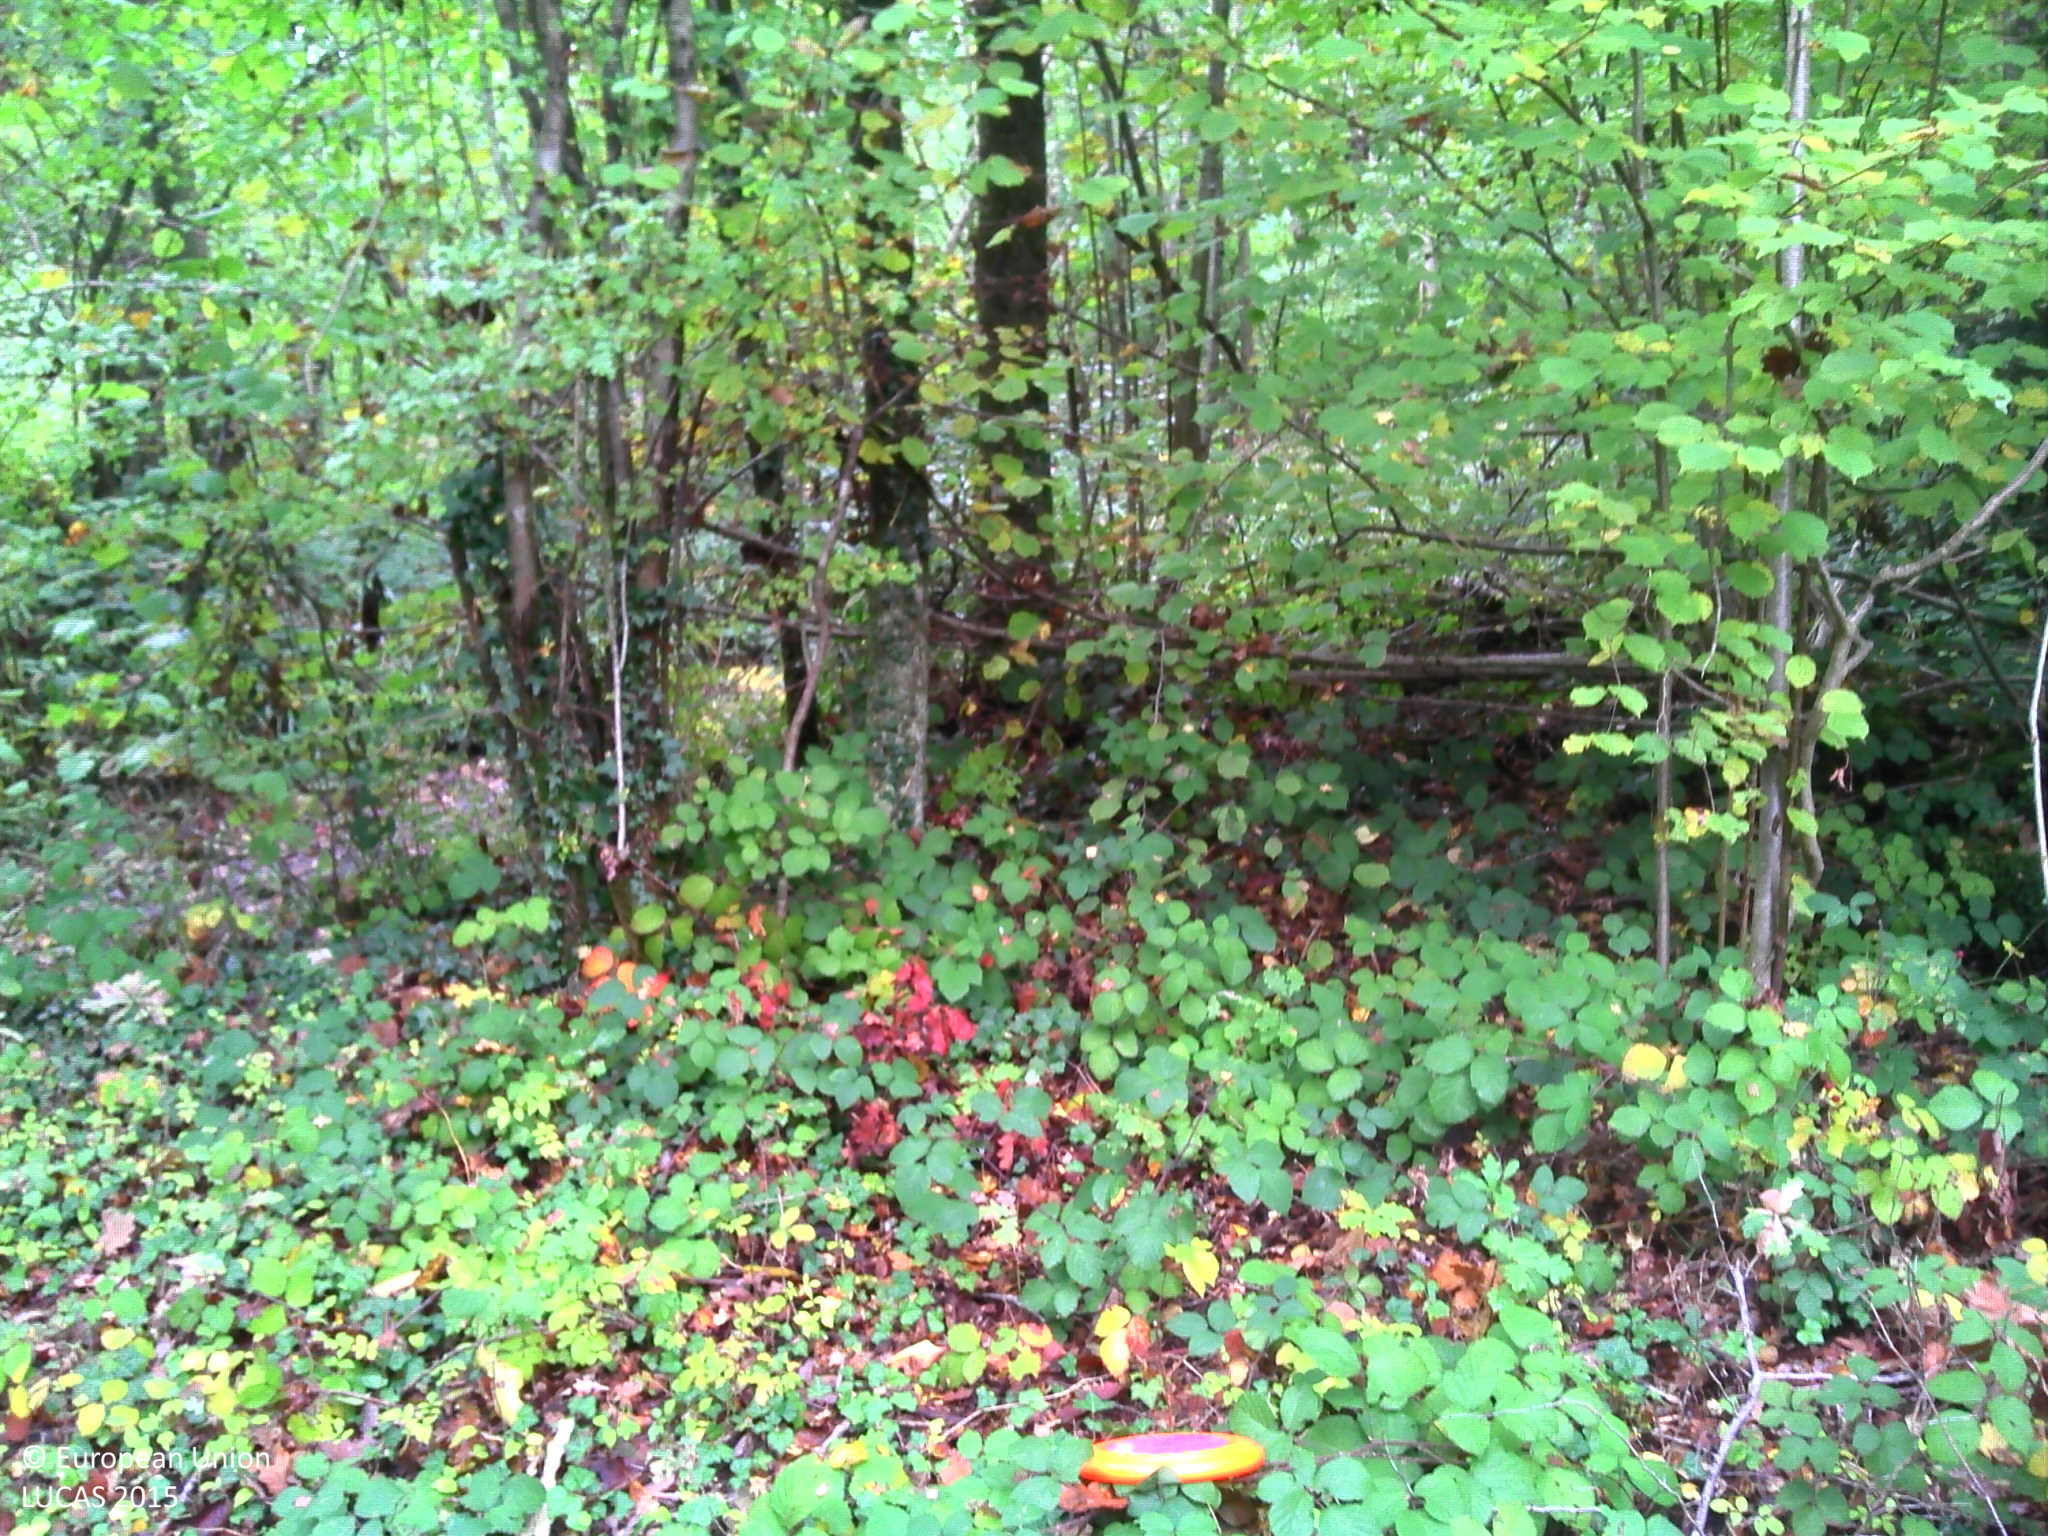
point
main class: Woodland
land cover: Broadleaved woodland
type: acidophilous oak and oak-birch forest
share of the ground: > 75 %
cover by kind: broadleaved forest trees 75 %, herbaceous plants 20 %, shrubs 5 %
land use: Forestry
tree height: > 5 m
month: October
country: FR
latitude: 49.0325
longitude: 3.3315
